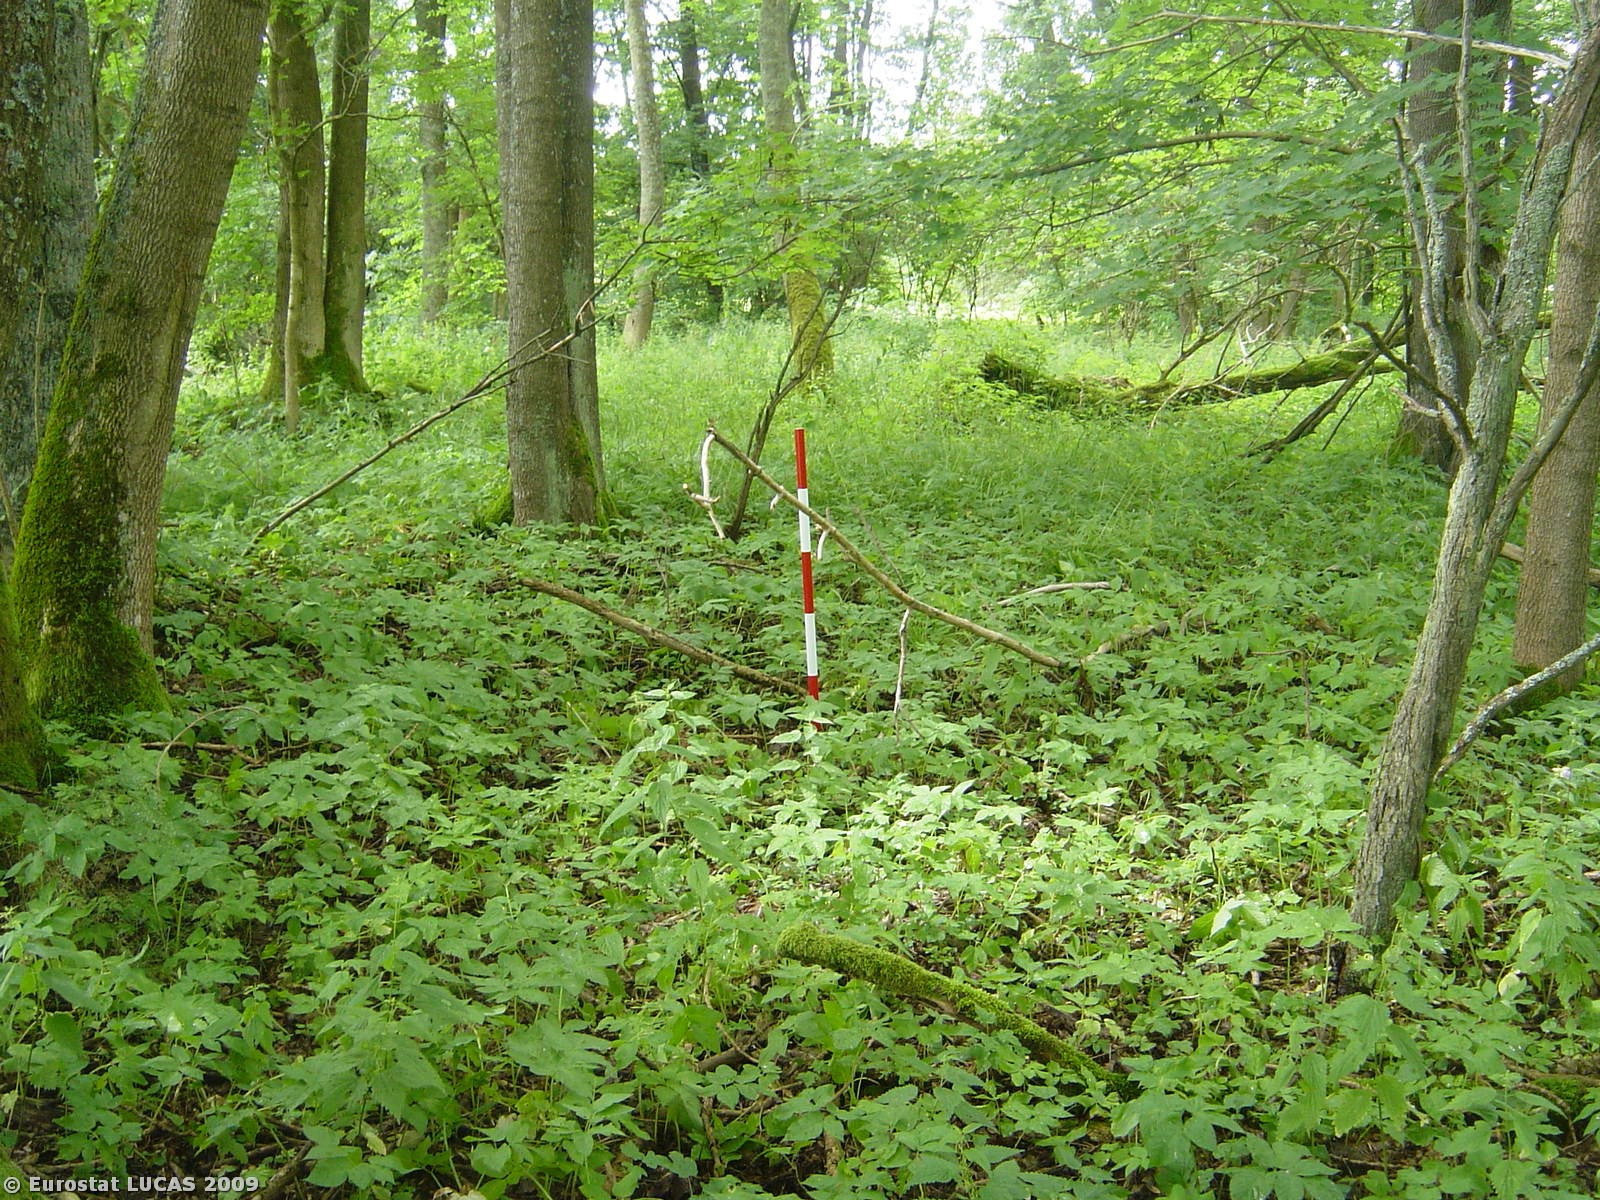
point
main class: Woodland
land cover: Broadleaved woodland
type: mesophytic deciduous forest
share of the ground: > 75 %
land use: Forestry
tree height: > 5 m
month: July
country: CZ
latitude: 49.6882
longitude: 12.5363
